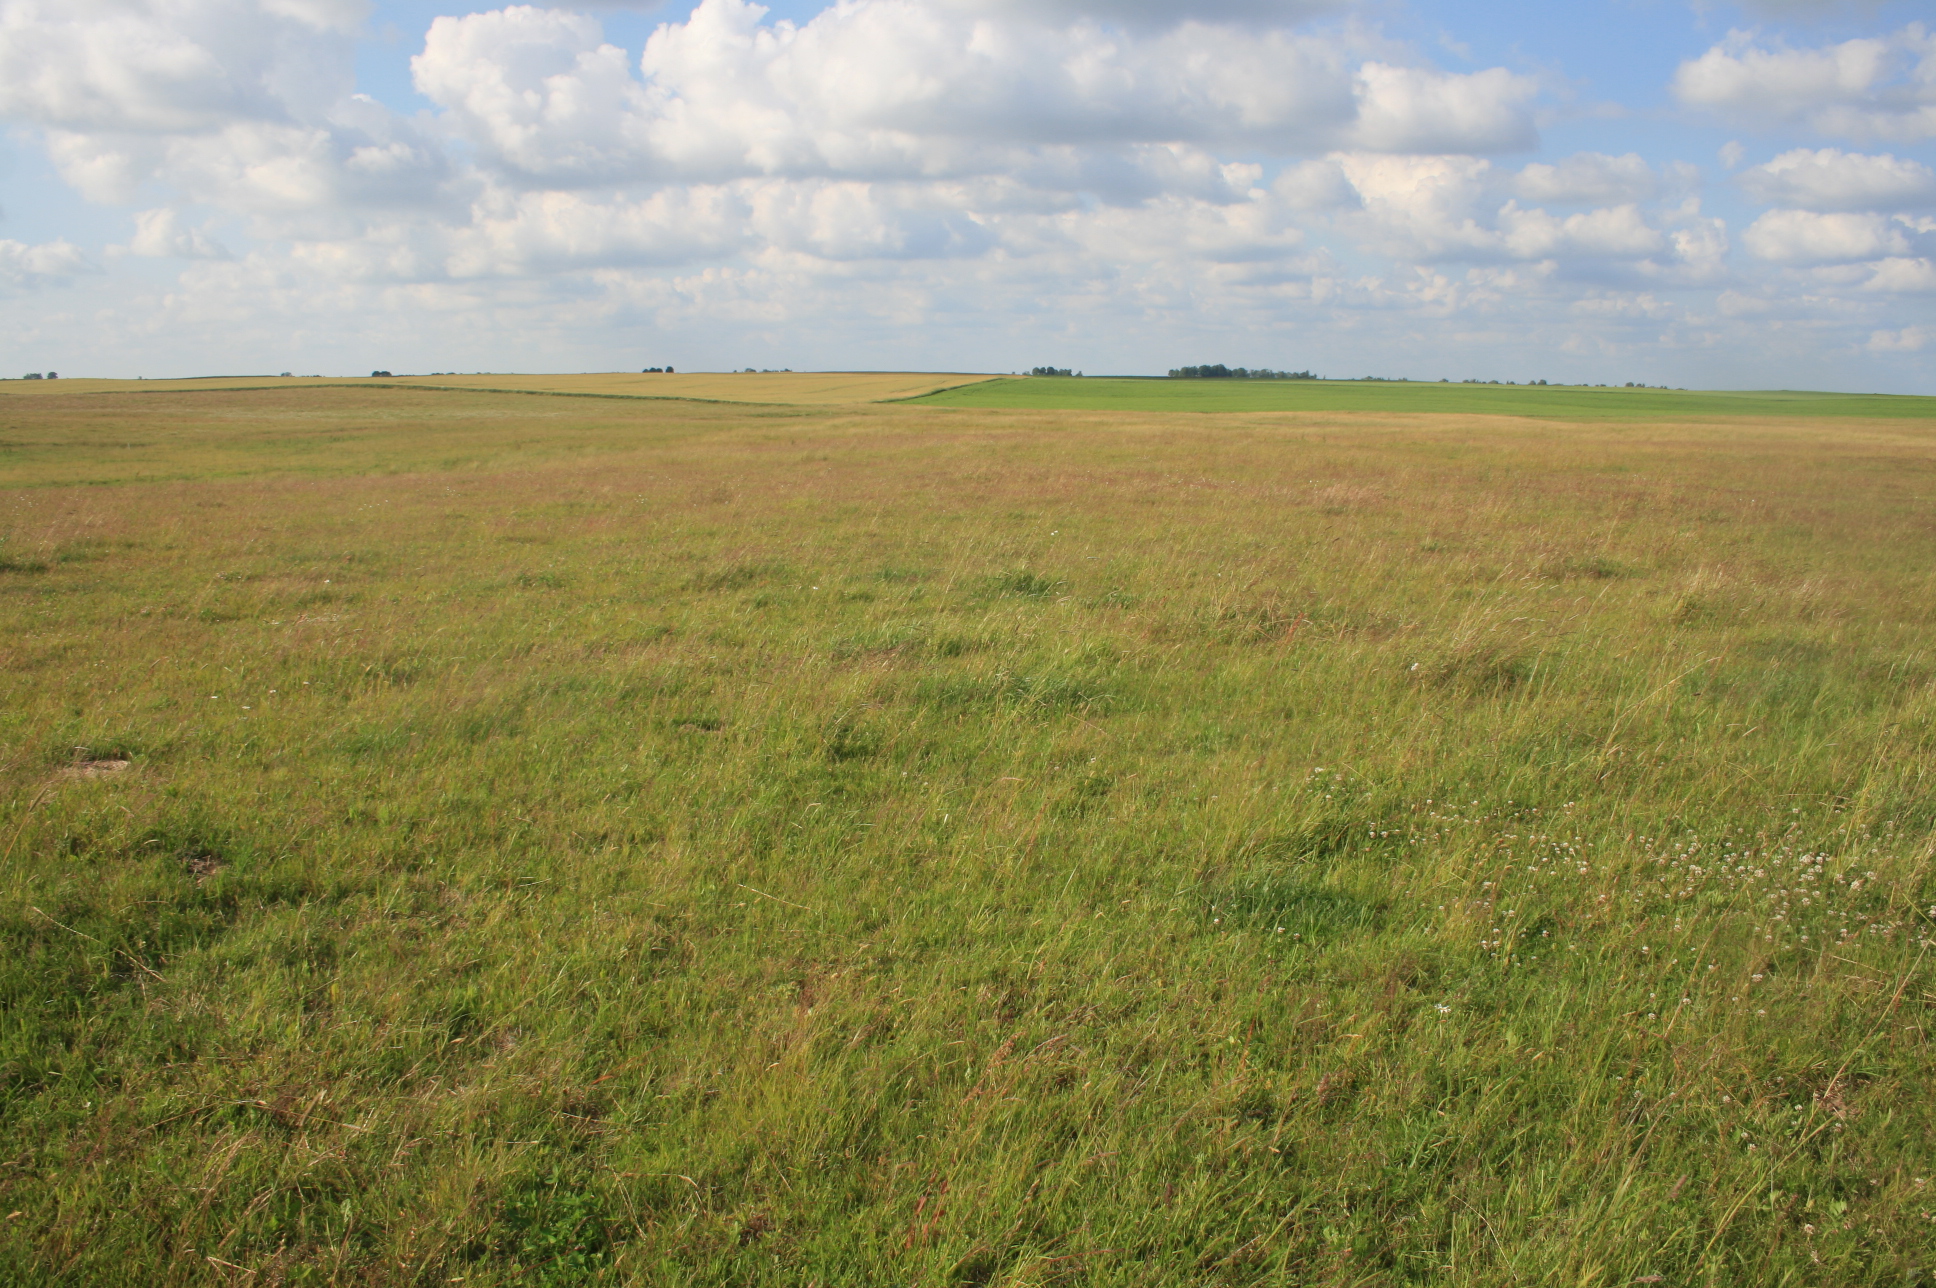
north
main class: Grassland
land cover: Grassland without tree/shrub cover
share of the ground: > 75 %
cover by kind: herbaceous plants 100 %
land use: Agriculture (excluding fallow land and kitchen gardens)
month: June
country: LT
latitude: 55.2056
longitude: 21.9802
